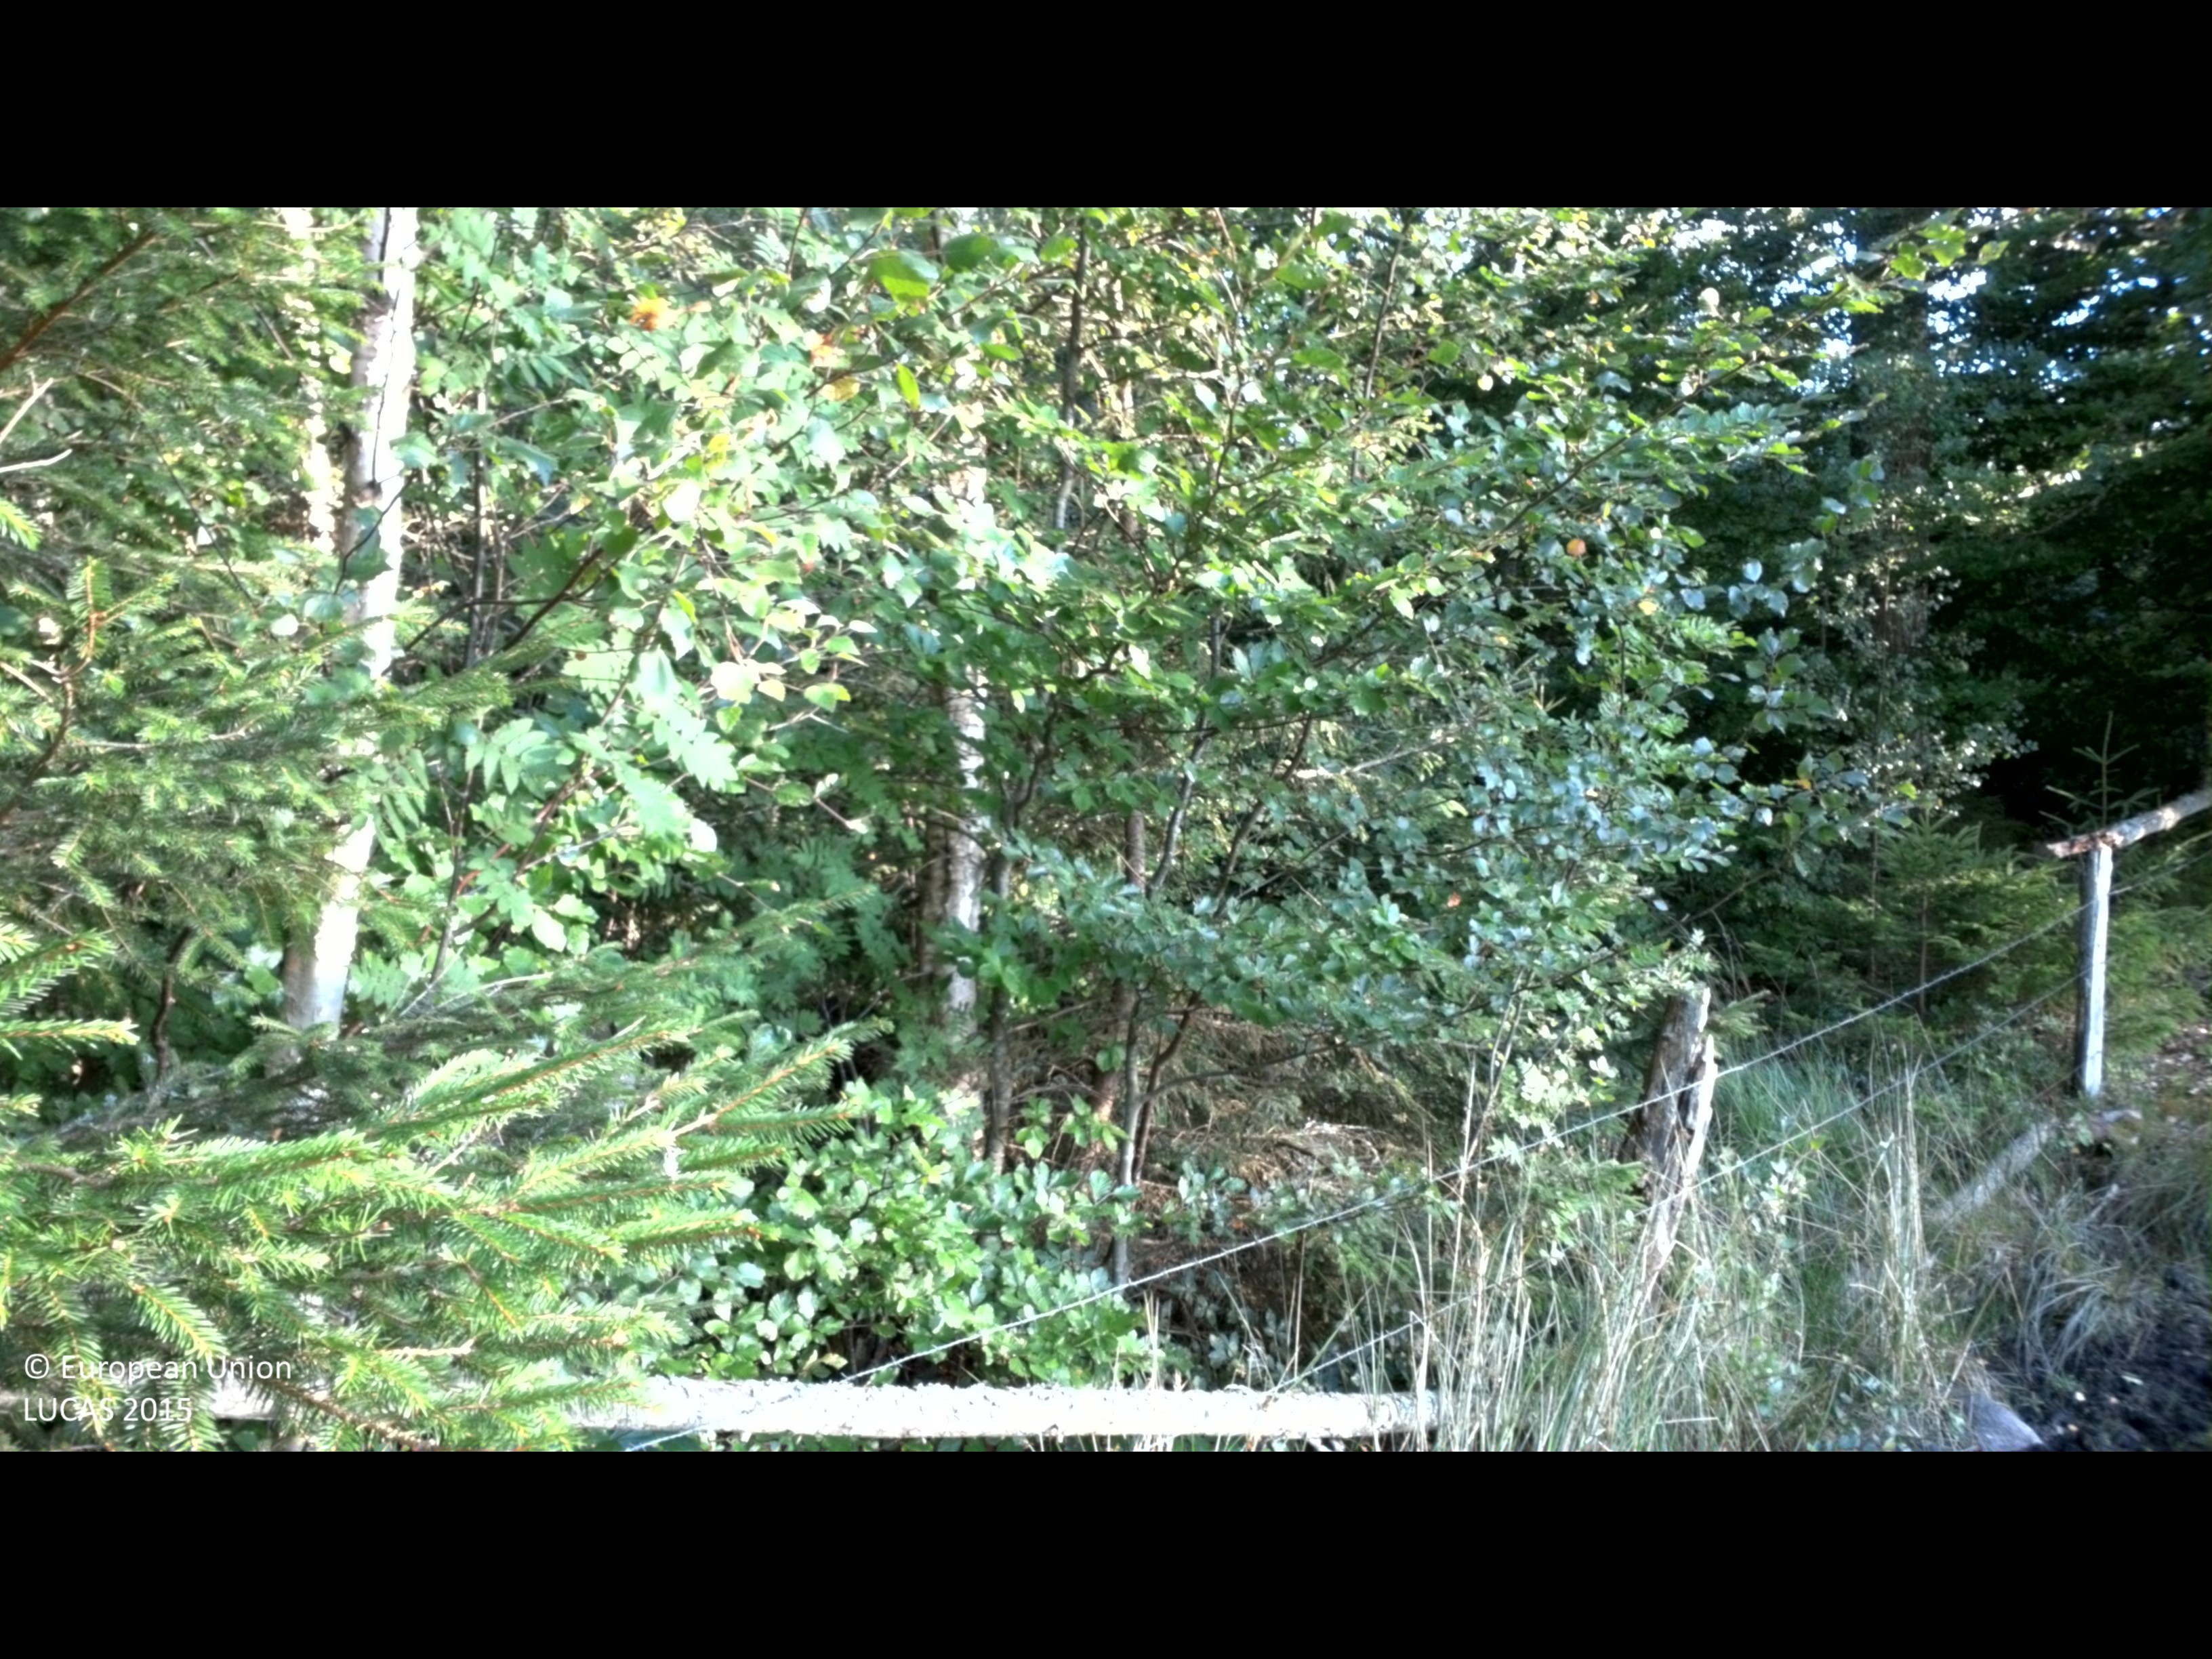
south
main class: Grassland
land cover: Grassland without tree/shrub cover
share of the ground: > 75 %
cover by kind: herbaceous plants 85 %, unconsolidated bare surface 15 %
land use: Agriculture (excluding fallow land and kitchen gardens)
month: August
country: SE
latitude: 56.2169
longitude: 15.4337
